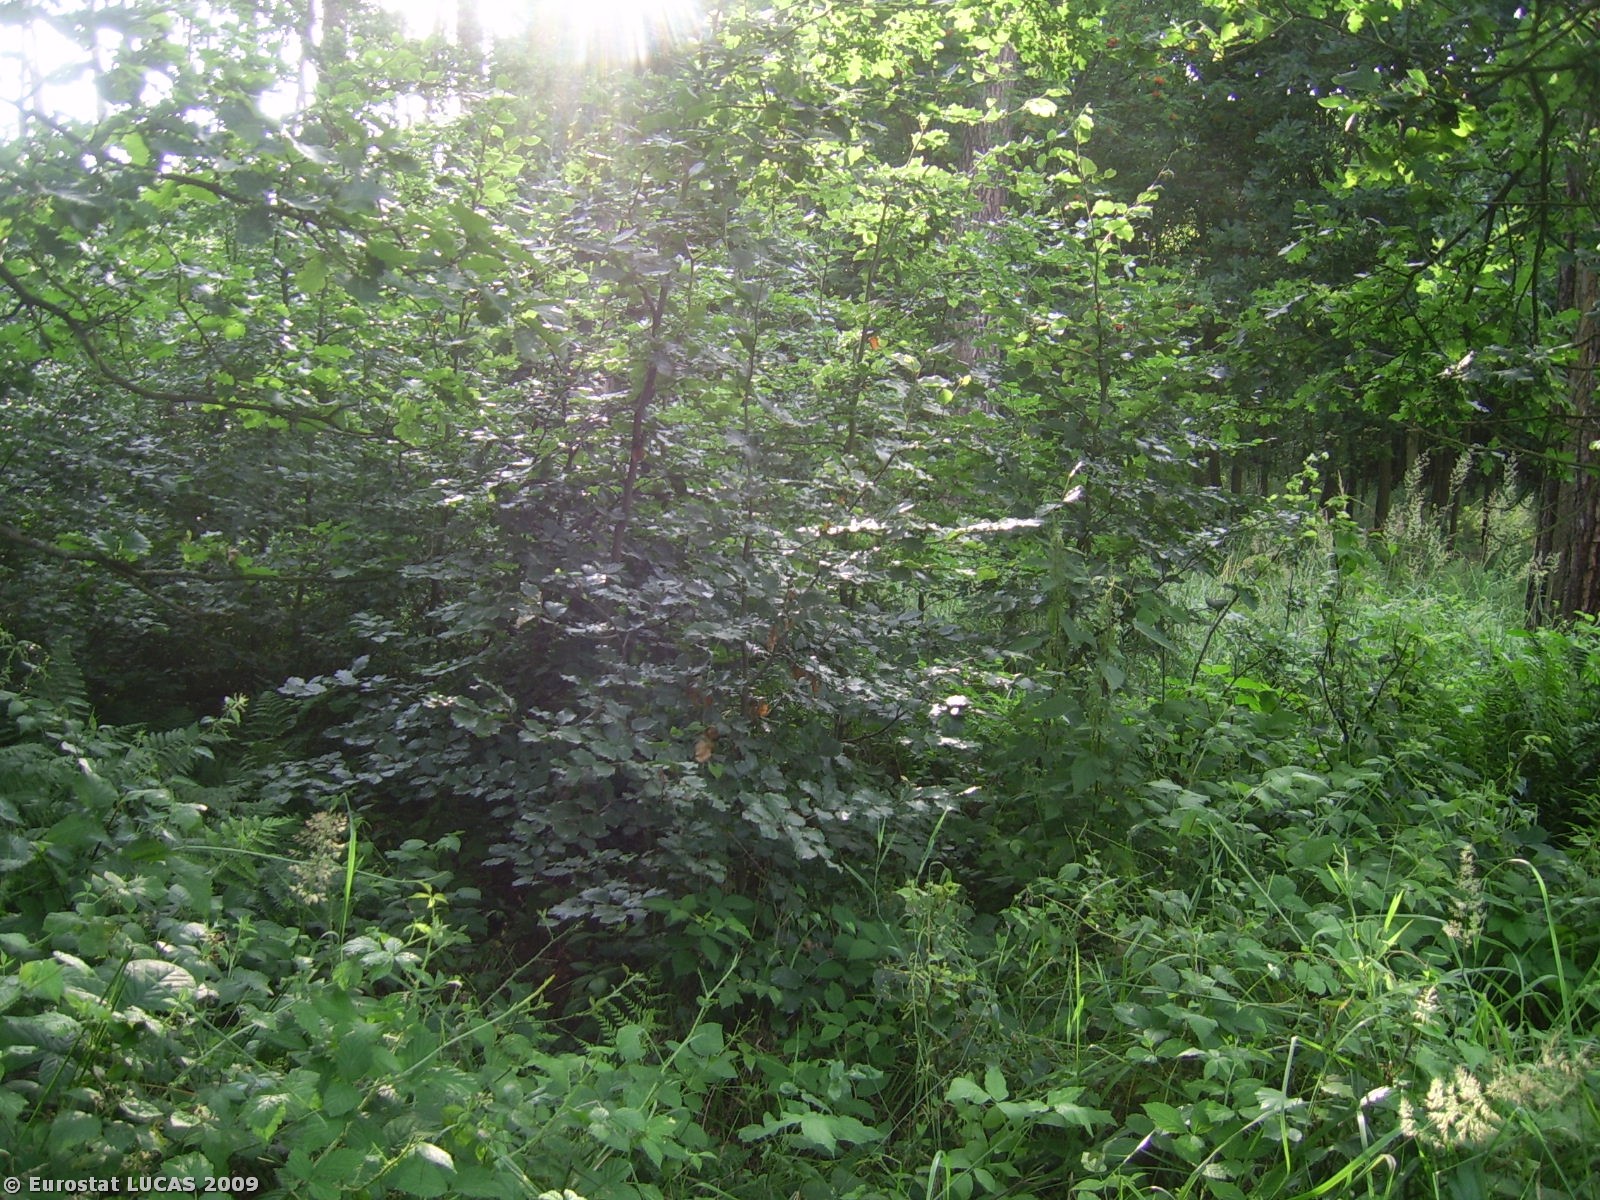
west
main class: Woodland
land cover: Mixed woodland
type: hemiboreal forest and nemoral coniferous forest and mixed broadleaved-coniferous forest
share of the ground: 50 - 75 %
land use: Nature reserves
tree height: > 5 m
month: July
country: PL
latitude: 52.5334
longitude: 18.1096
